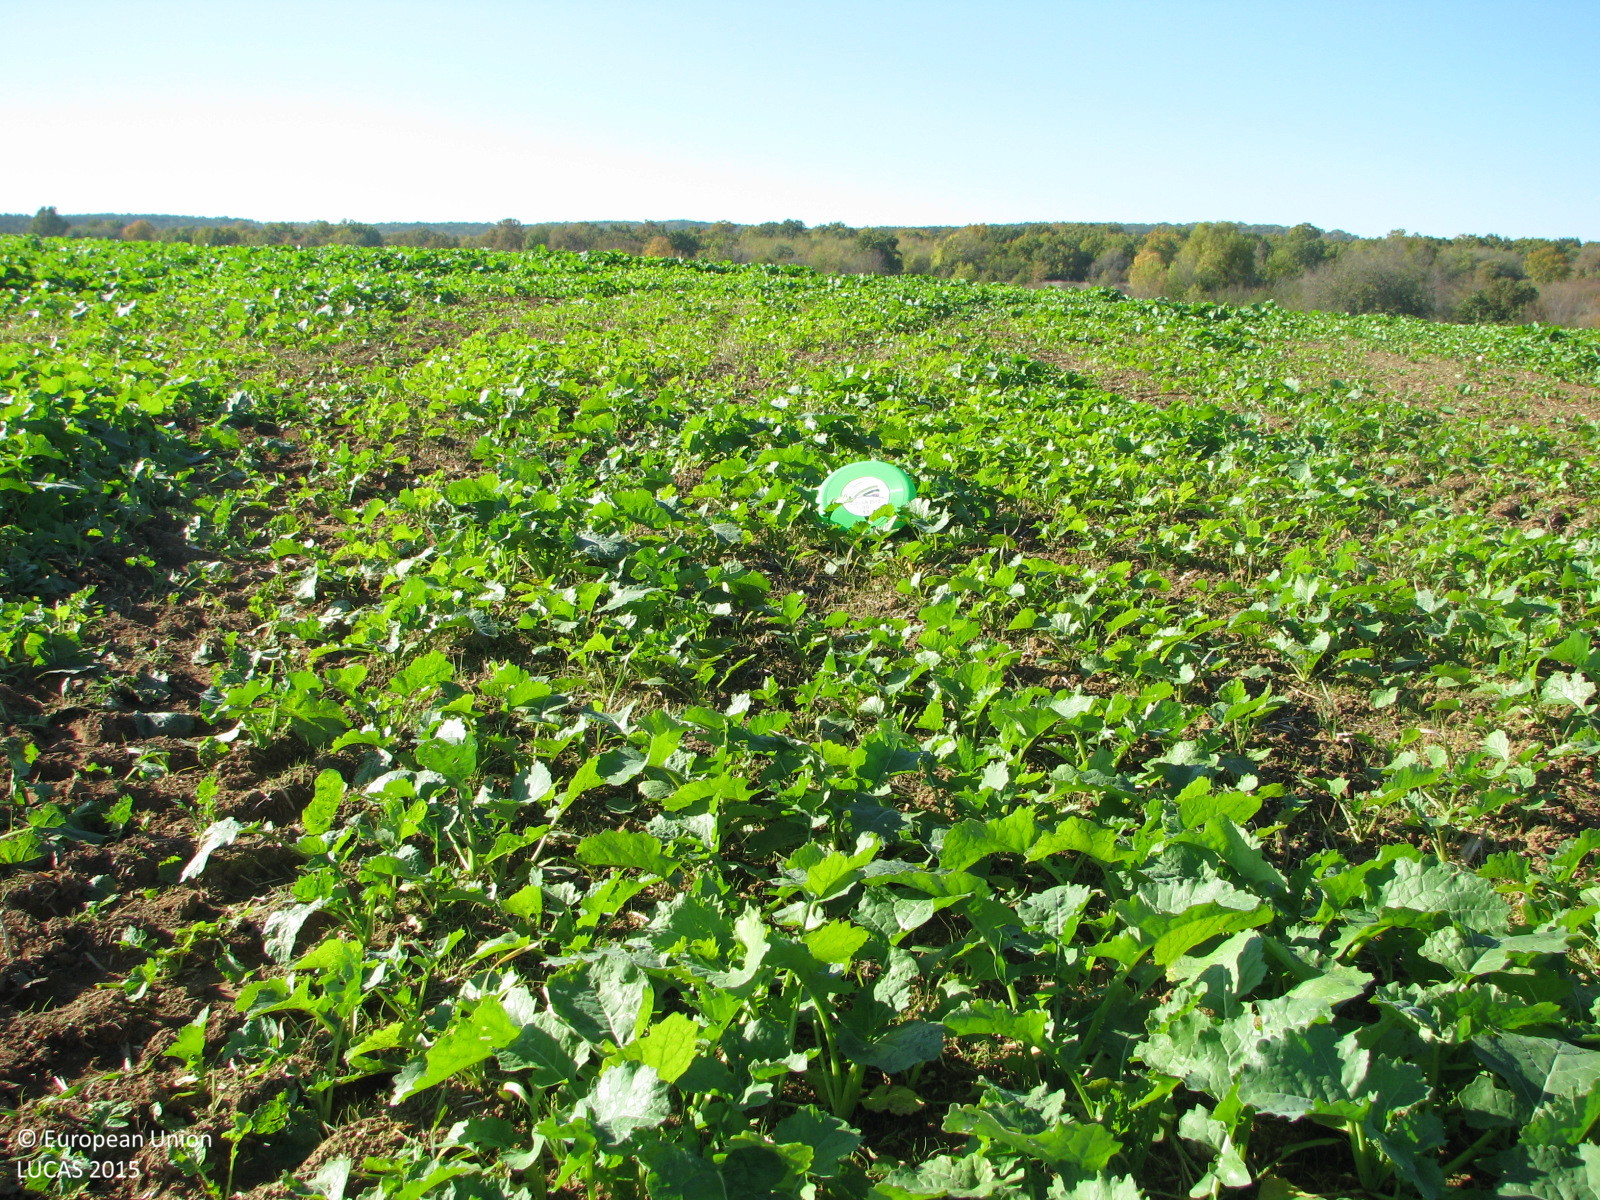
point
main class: Cropland
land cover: Rape and turnip rape
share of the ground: > 75 %
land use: Agriculture (excluding fallow land and kitchen gardens)
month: November
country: BG
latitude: 42.1186
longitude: 26.8228
